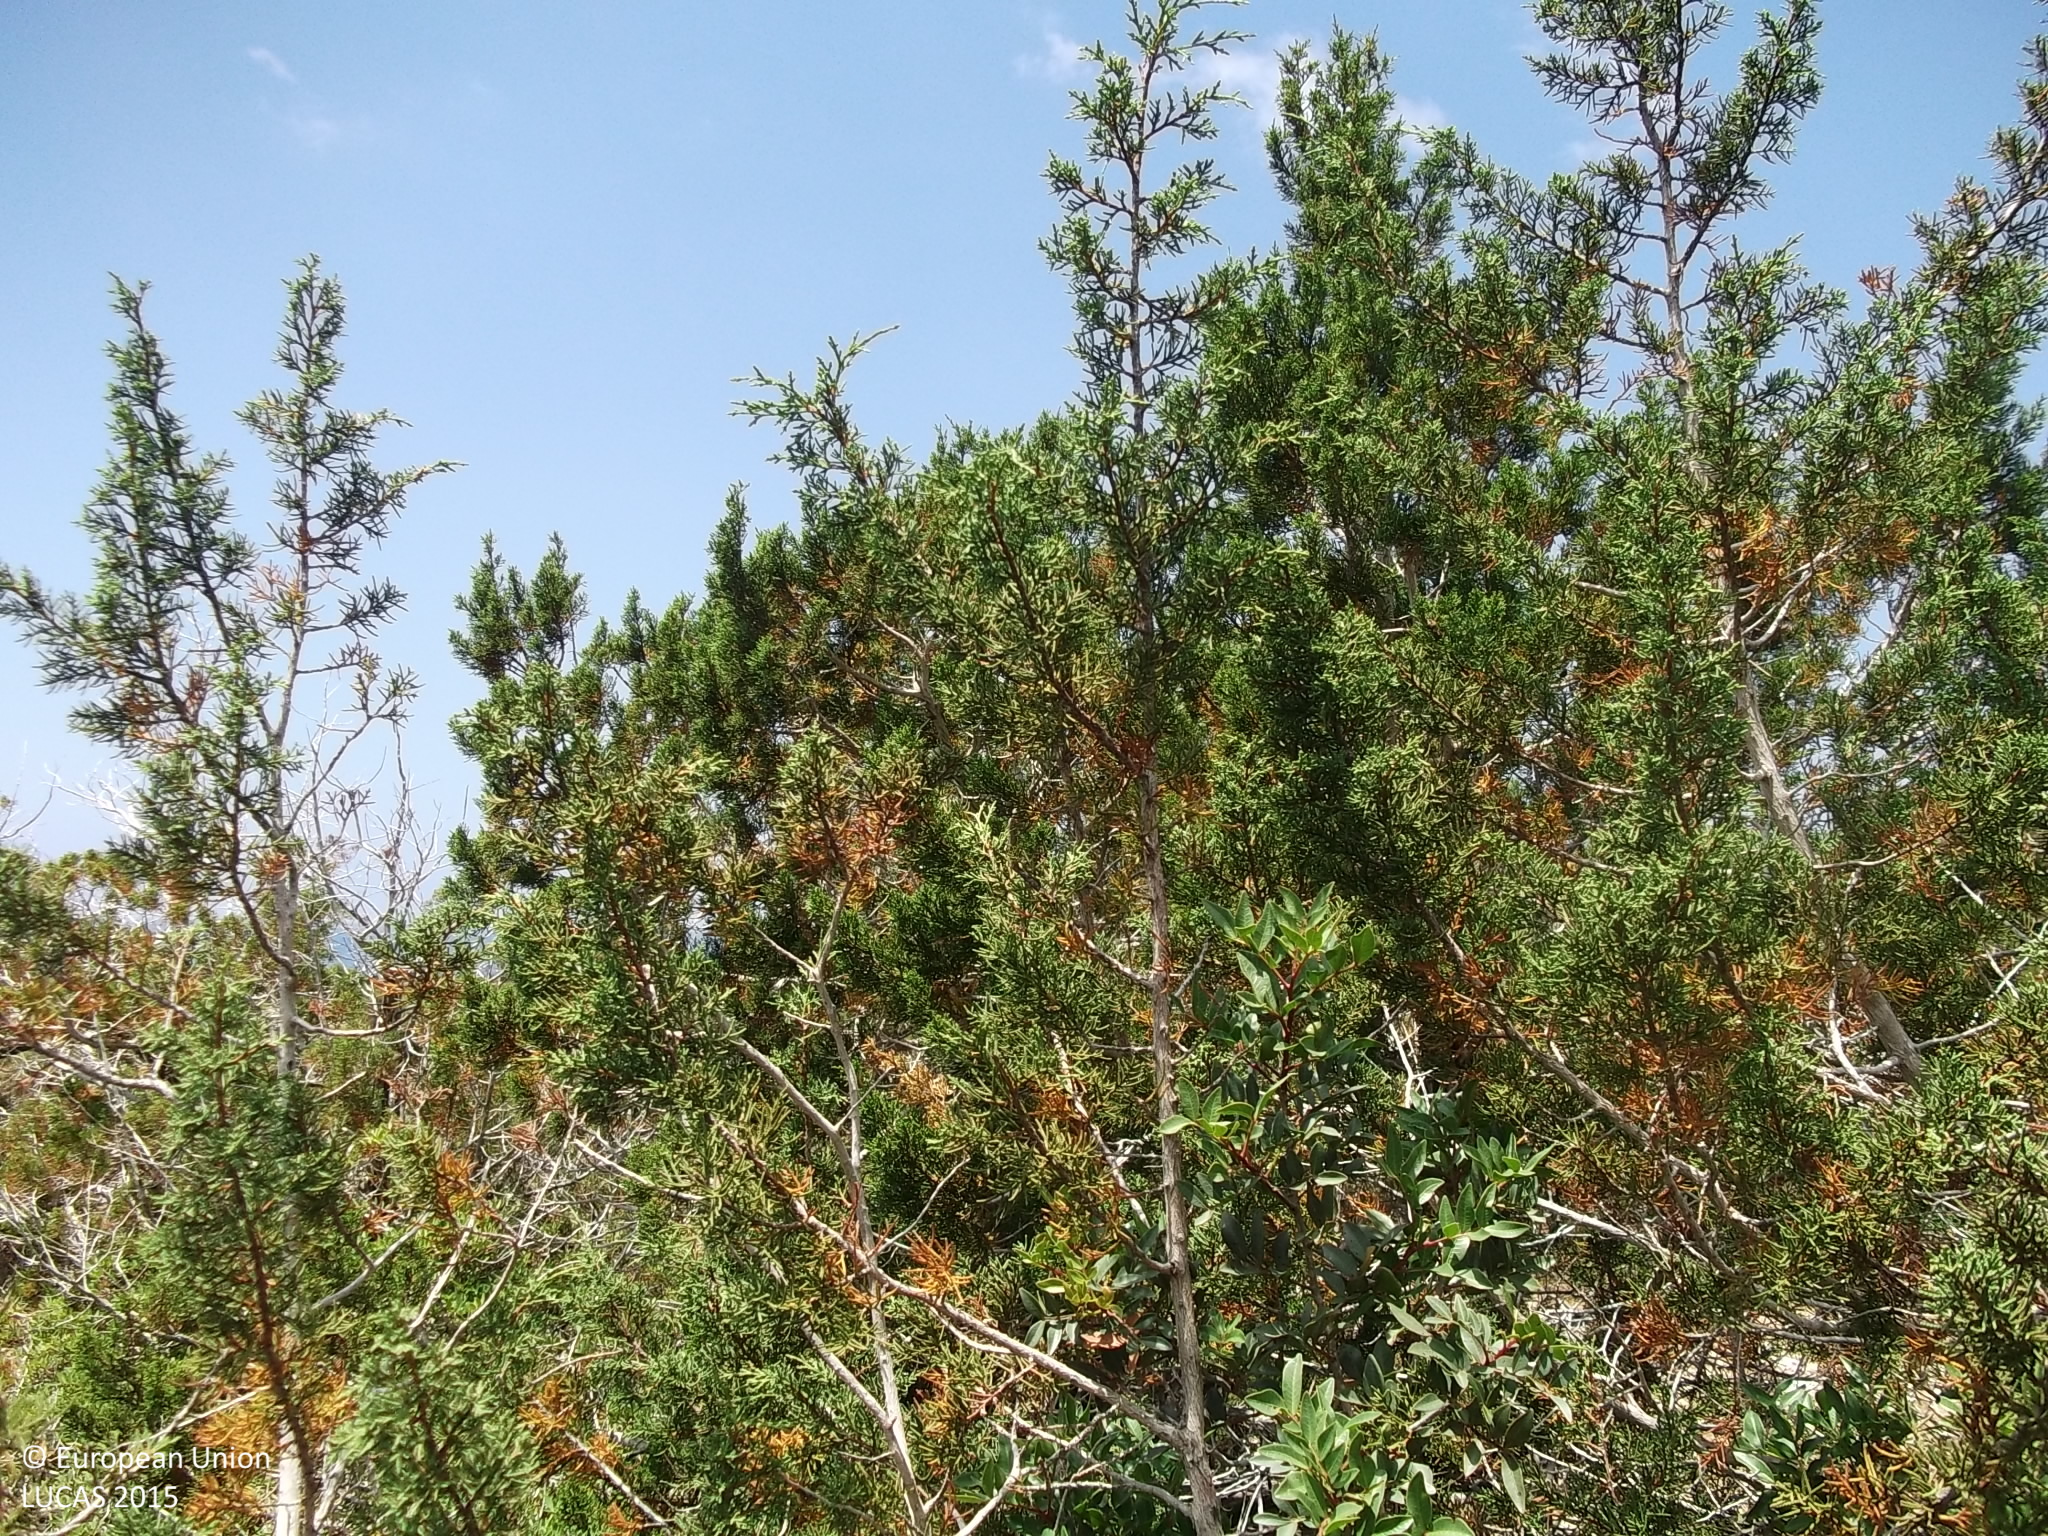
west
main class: Woodland
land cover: Other coniferous woodland
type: coniferous forest of the mediterranean region
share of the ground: > 75 %
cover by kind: coniferous forest trees 100 %
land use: Forestry
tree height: > 5 m
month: May
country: CY
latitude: 35.0490
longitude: 32.2835
